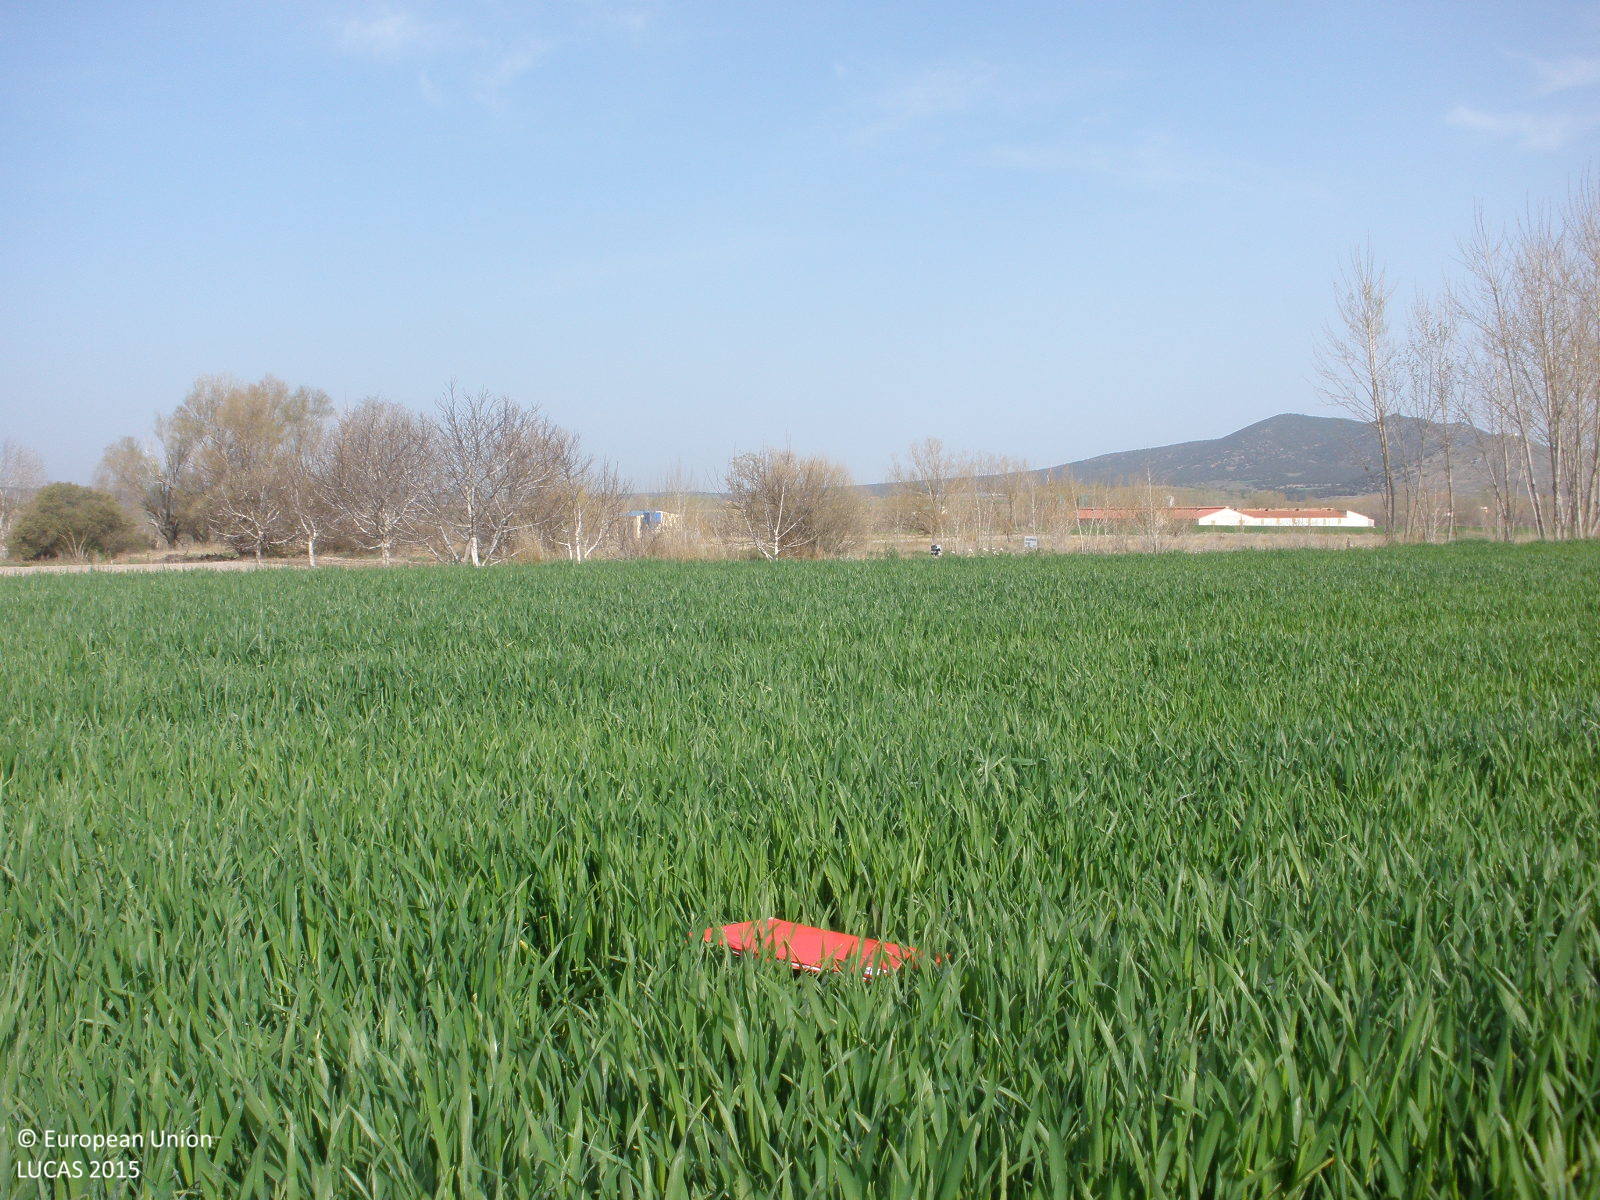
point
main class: Cropland
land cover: Common wheat
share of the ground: > 75 %
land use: Agriculture (excluding fallow land and kitchen gardens)
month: April
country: ES
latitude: 40.8505
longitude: -1.3217
